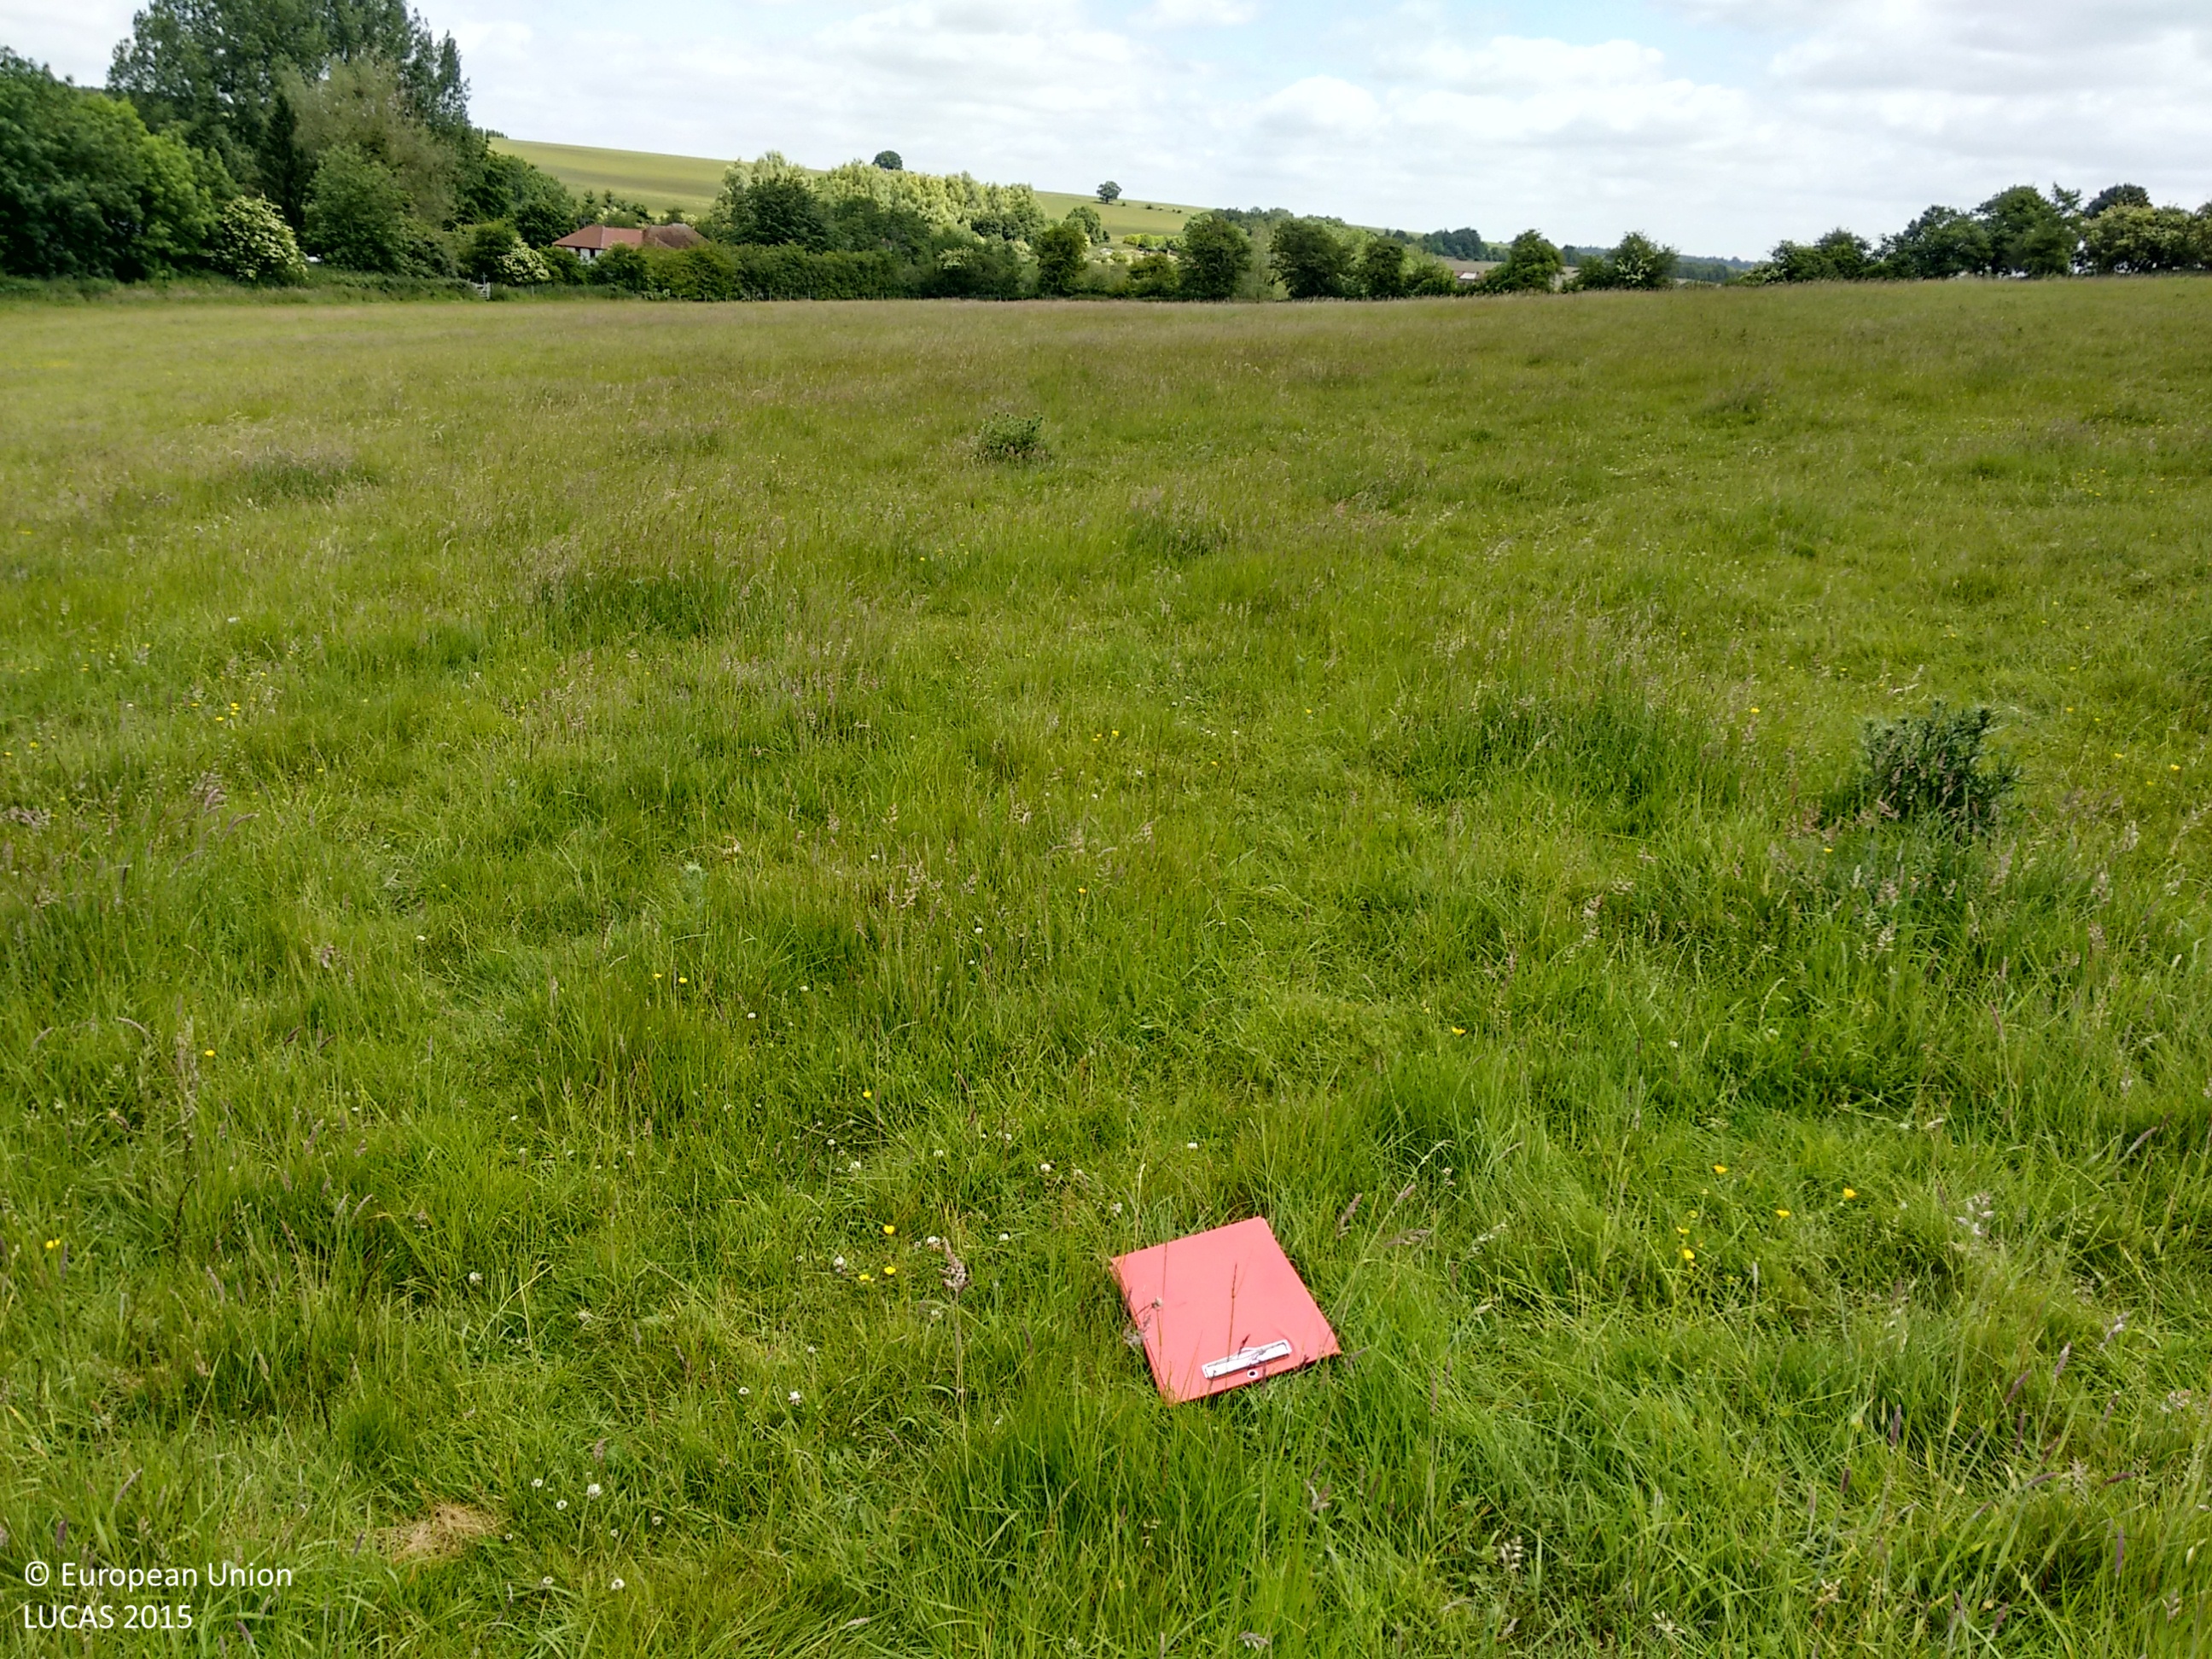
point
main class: Grassland
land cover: Grassland without tree/shrub cover
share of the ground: > 75 %
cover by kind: herbaceous plants 100 %
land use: Agriculture (excluding fallow land and kitchen gardens)
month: June
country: GB
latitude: 51.4128
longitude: -1.5398
